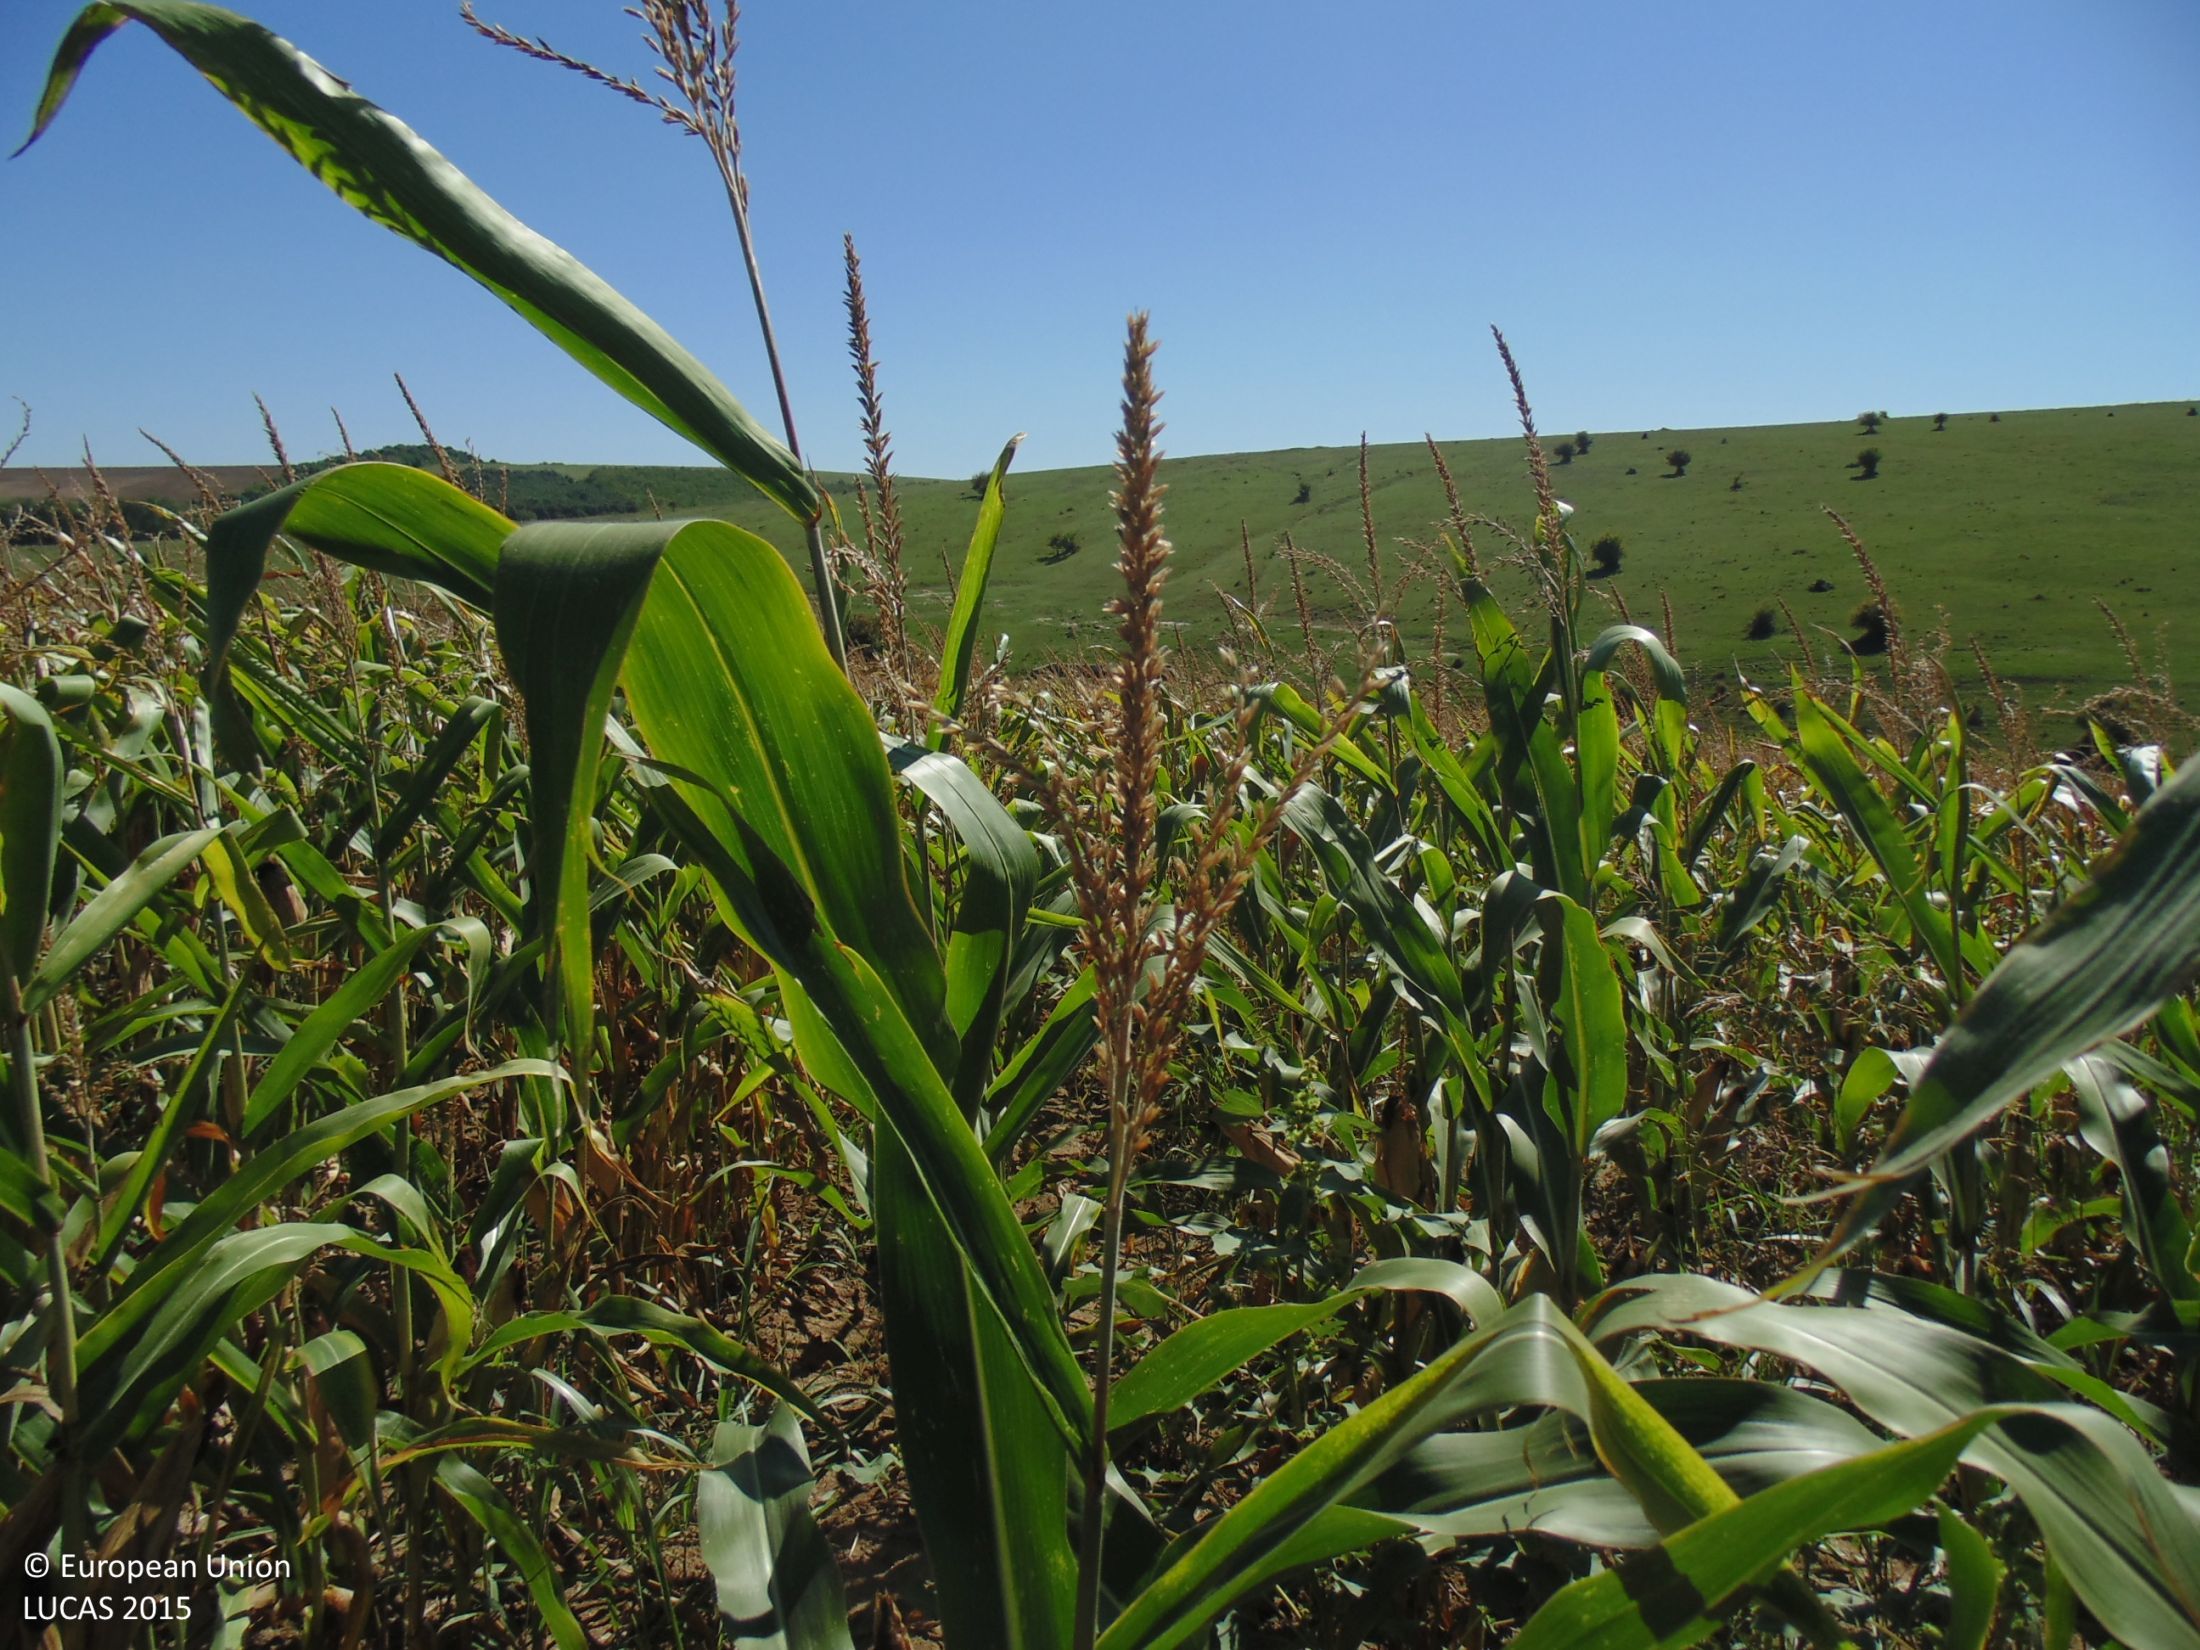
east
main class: Cropland
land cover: Maize
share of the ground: > 75 %
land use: Agriculture (excluding fallow land and kitchen gardens)
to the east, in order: Maize; Grassland with sparse tree/shrub cover; Tracks; Grassland with sparse tree/shrub cover; Inland marshes; Grassland with sparse tree/shrub cover
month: September
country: BG
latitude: 43.7930
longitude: 27.3682
